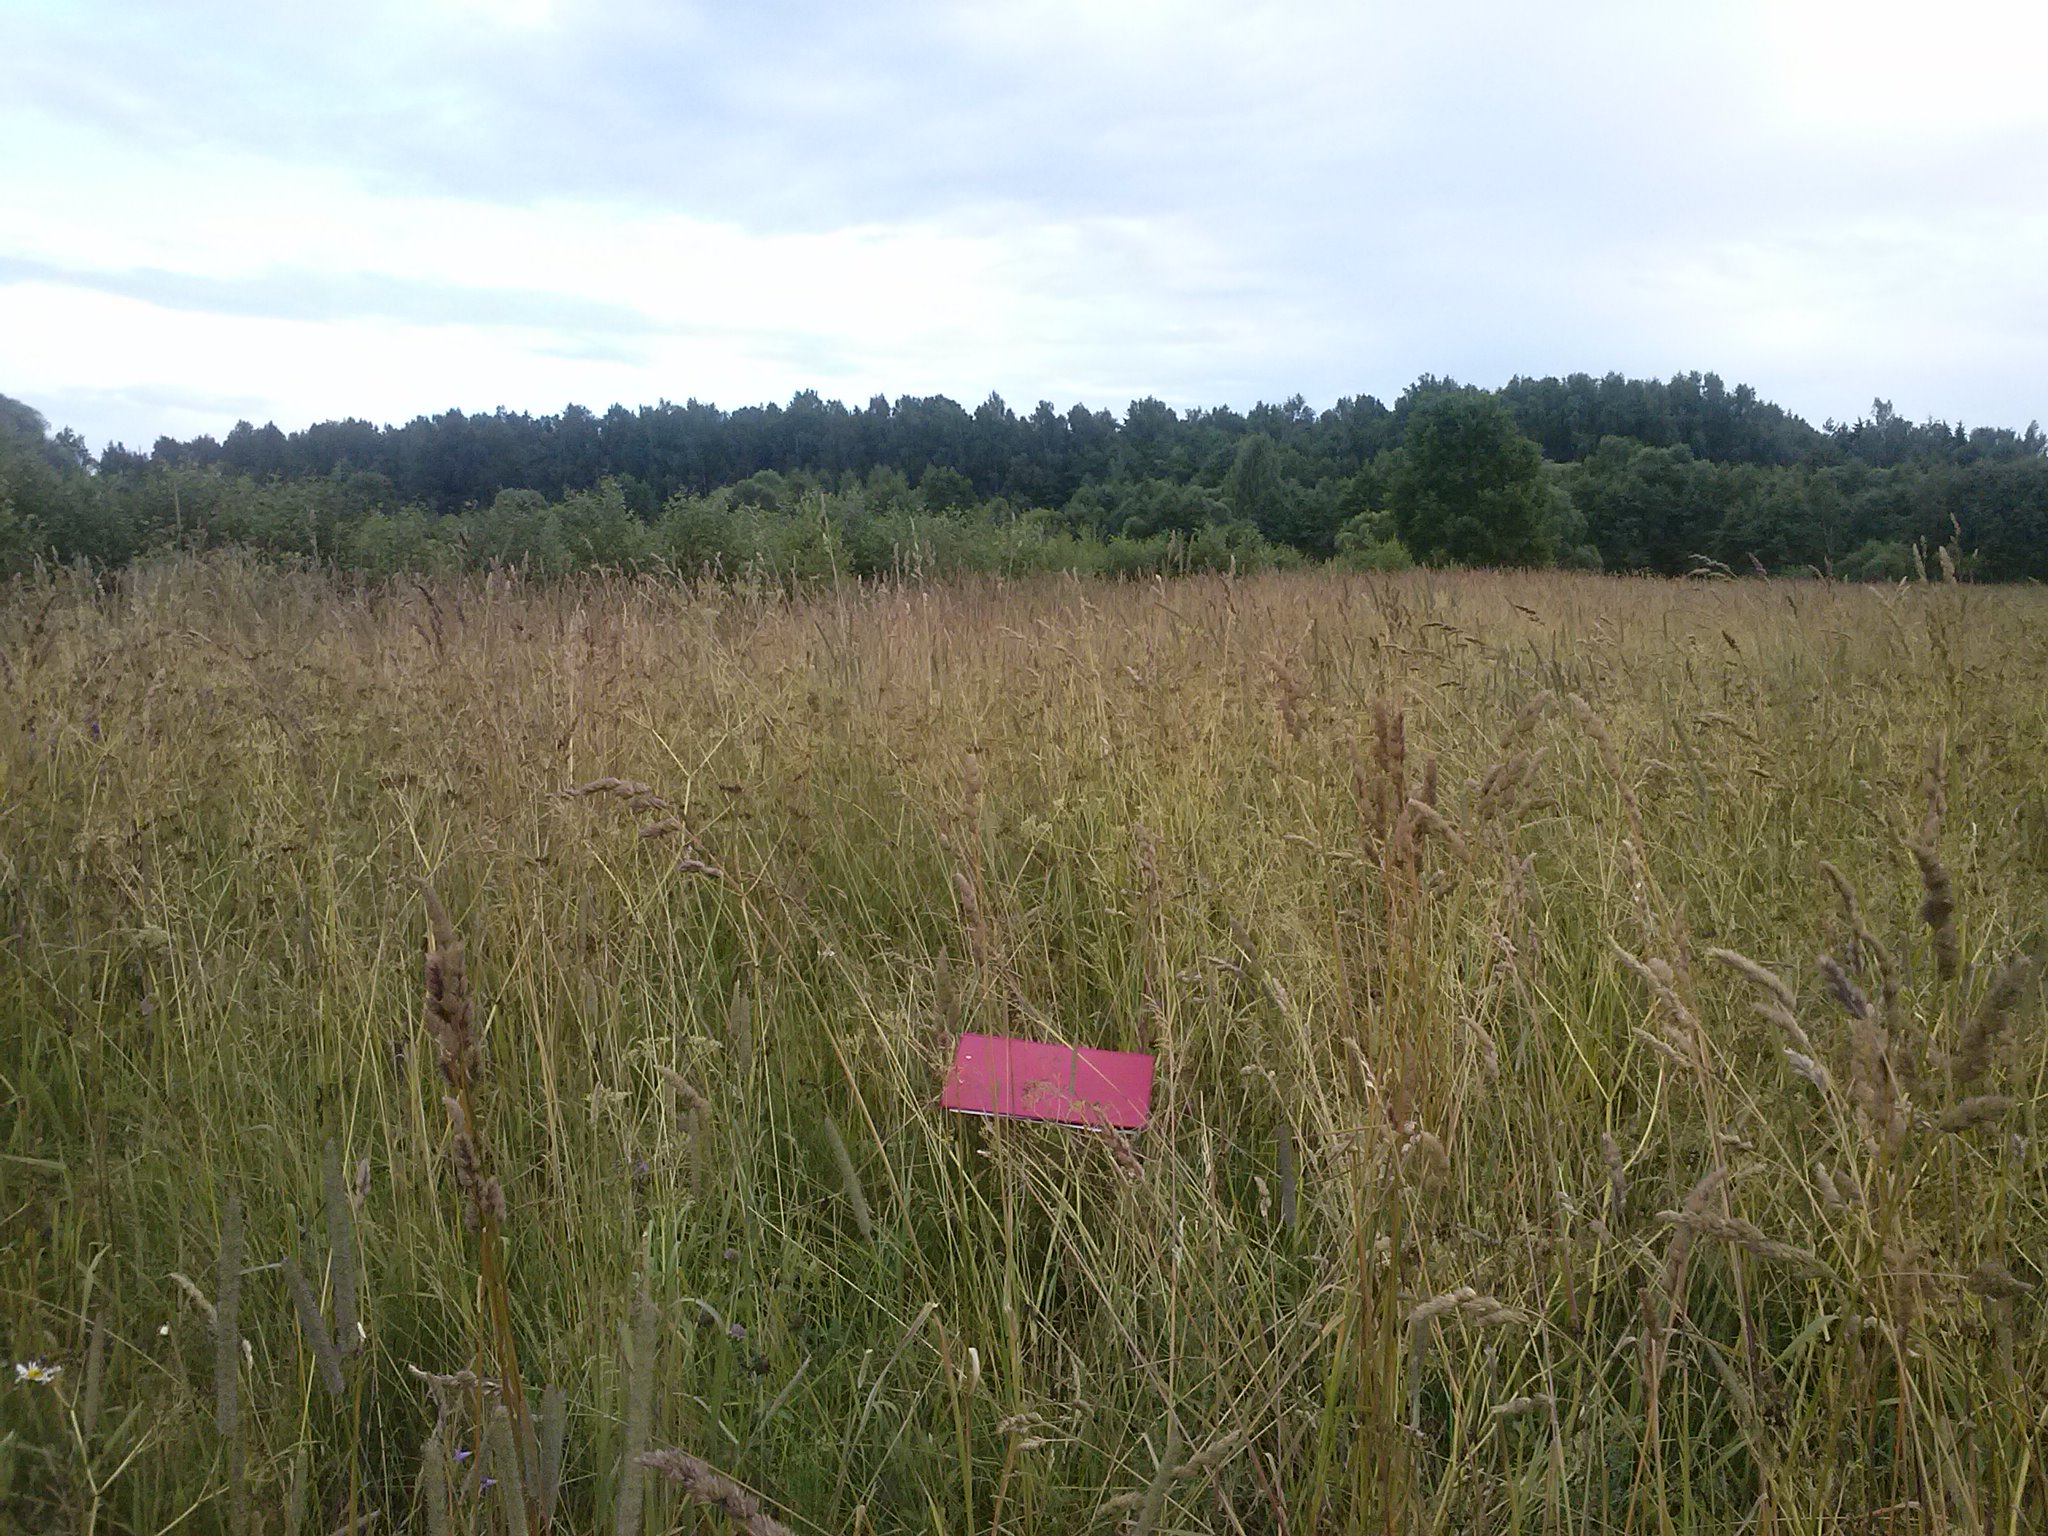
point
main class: Grassland
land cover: Grassland without tree/shrub cover
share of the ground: > 75 %
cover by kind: herbaceous plants 100 %
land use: Agriculture (excluding fallow land and kitchen gardens)
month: July
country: LV
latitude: 56.7606
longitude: 27.7718
